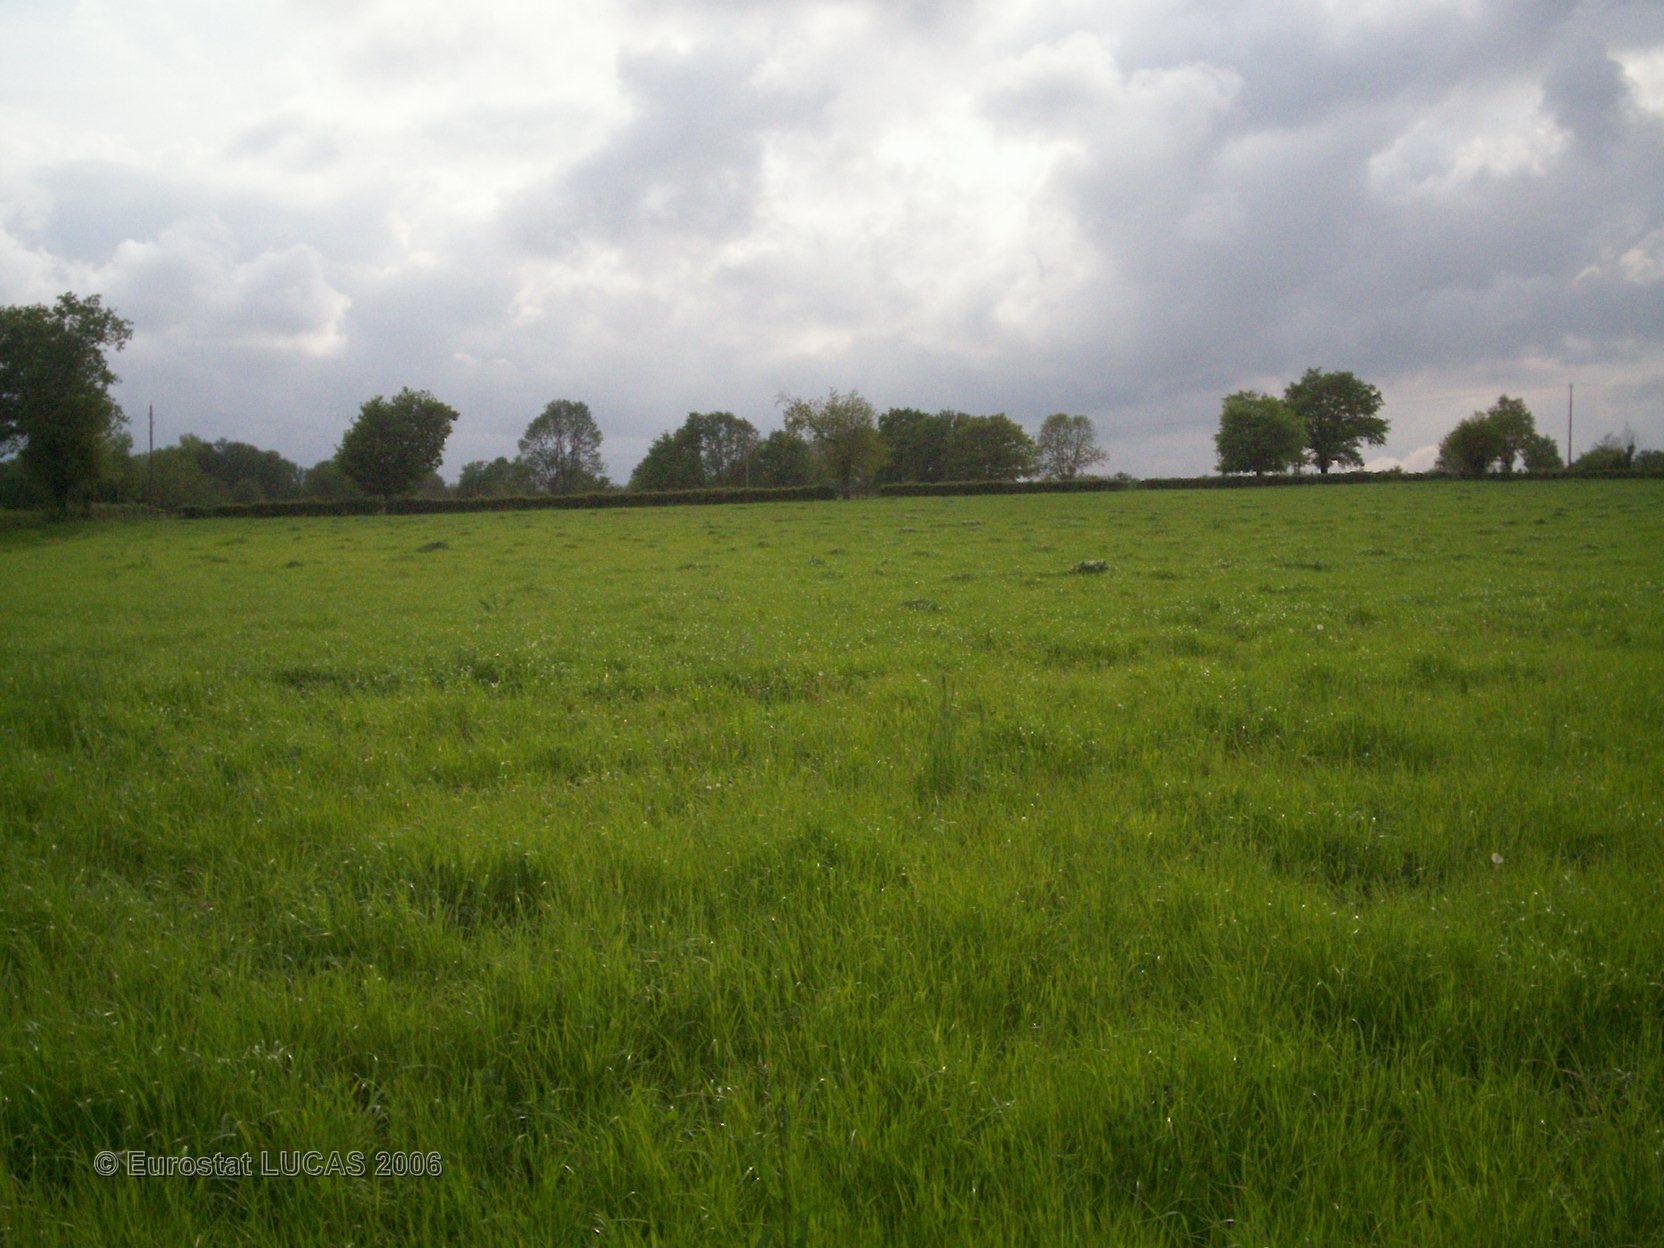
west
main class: Grassland
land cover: Grassland without tree/shrub cover
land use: Agriculture (excluding fallow land and kitchen gardens)
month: April
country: FR
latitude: 46.6835
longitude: -0.3414
